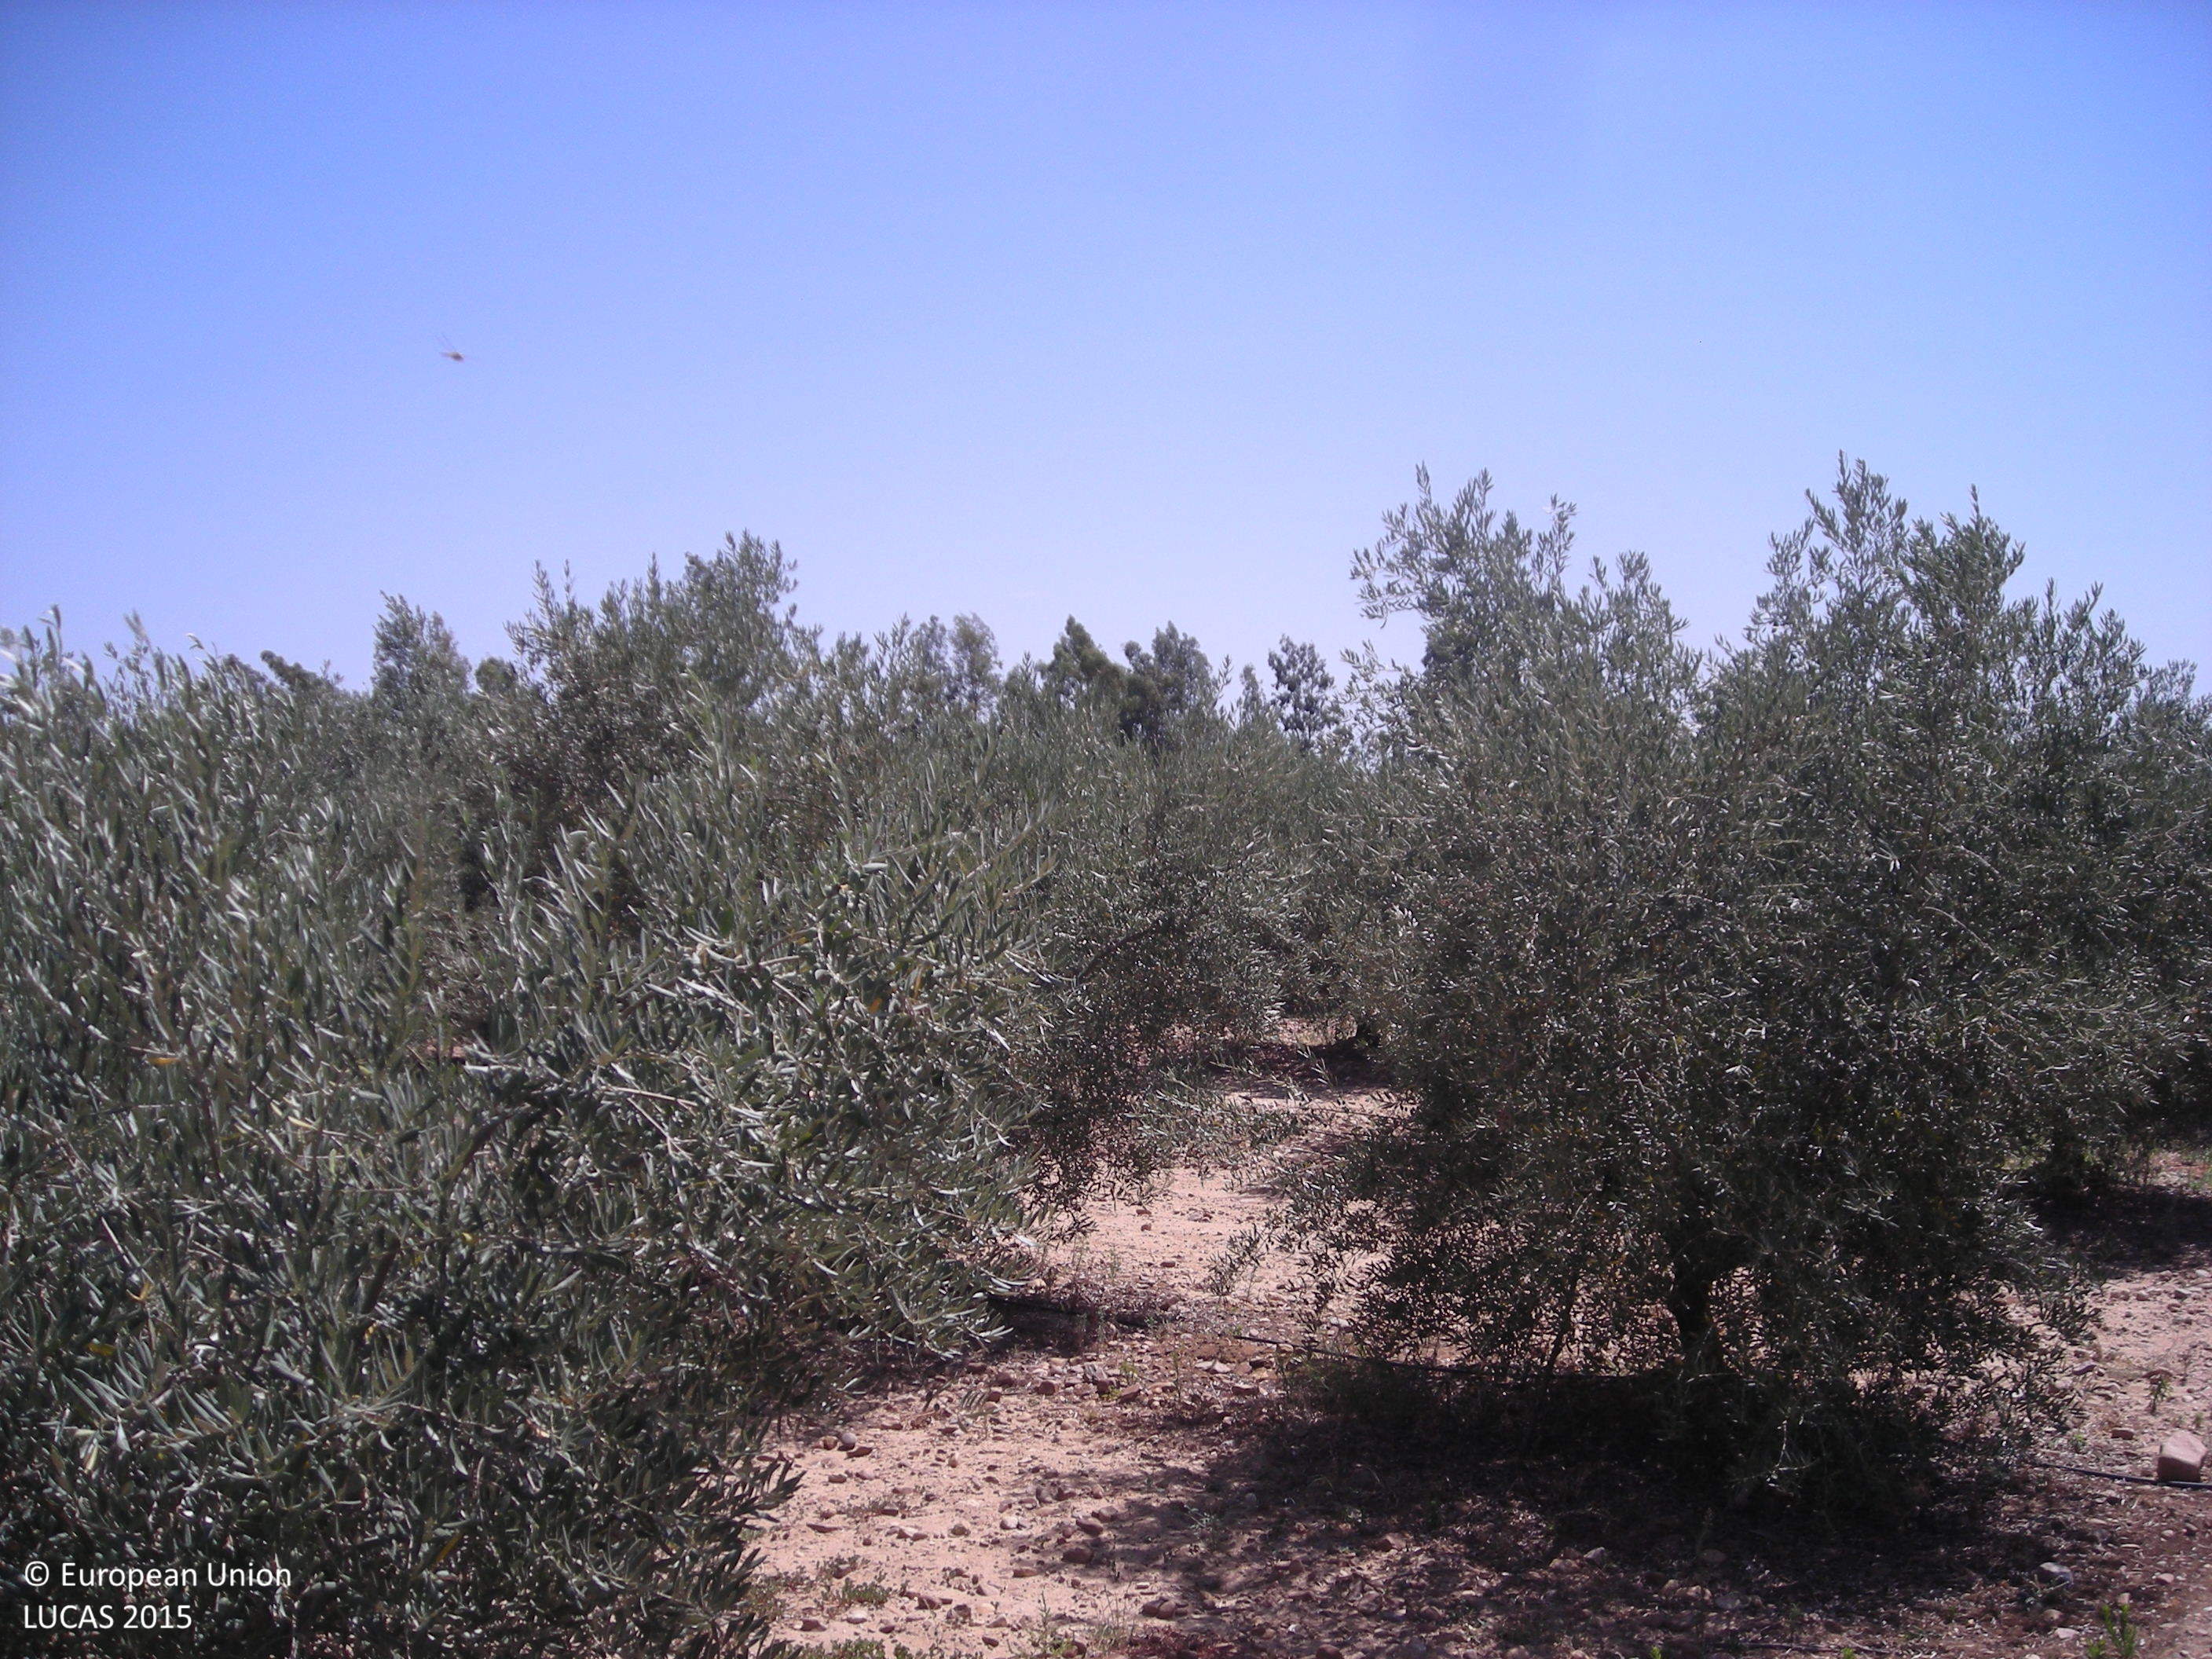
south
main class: Cropland
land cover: Olive groves
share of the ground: 25 - 50 %
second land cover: Other bare soil
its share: > 75 %
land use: Agriculture (excluding fallow land and kitchen gardens)
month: July
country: ES
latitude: 38.9685
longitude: -5.9673
